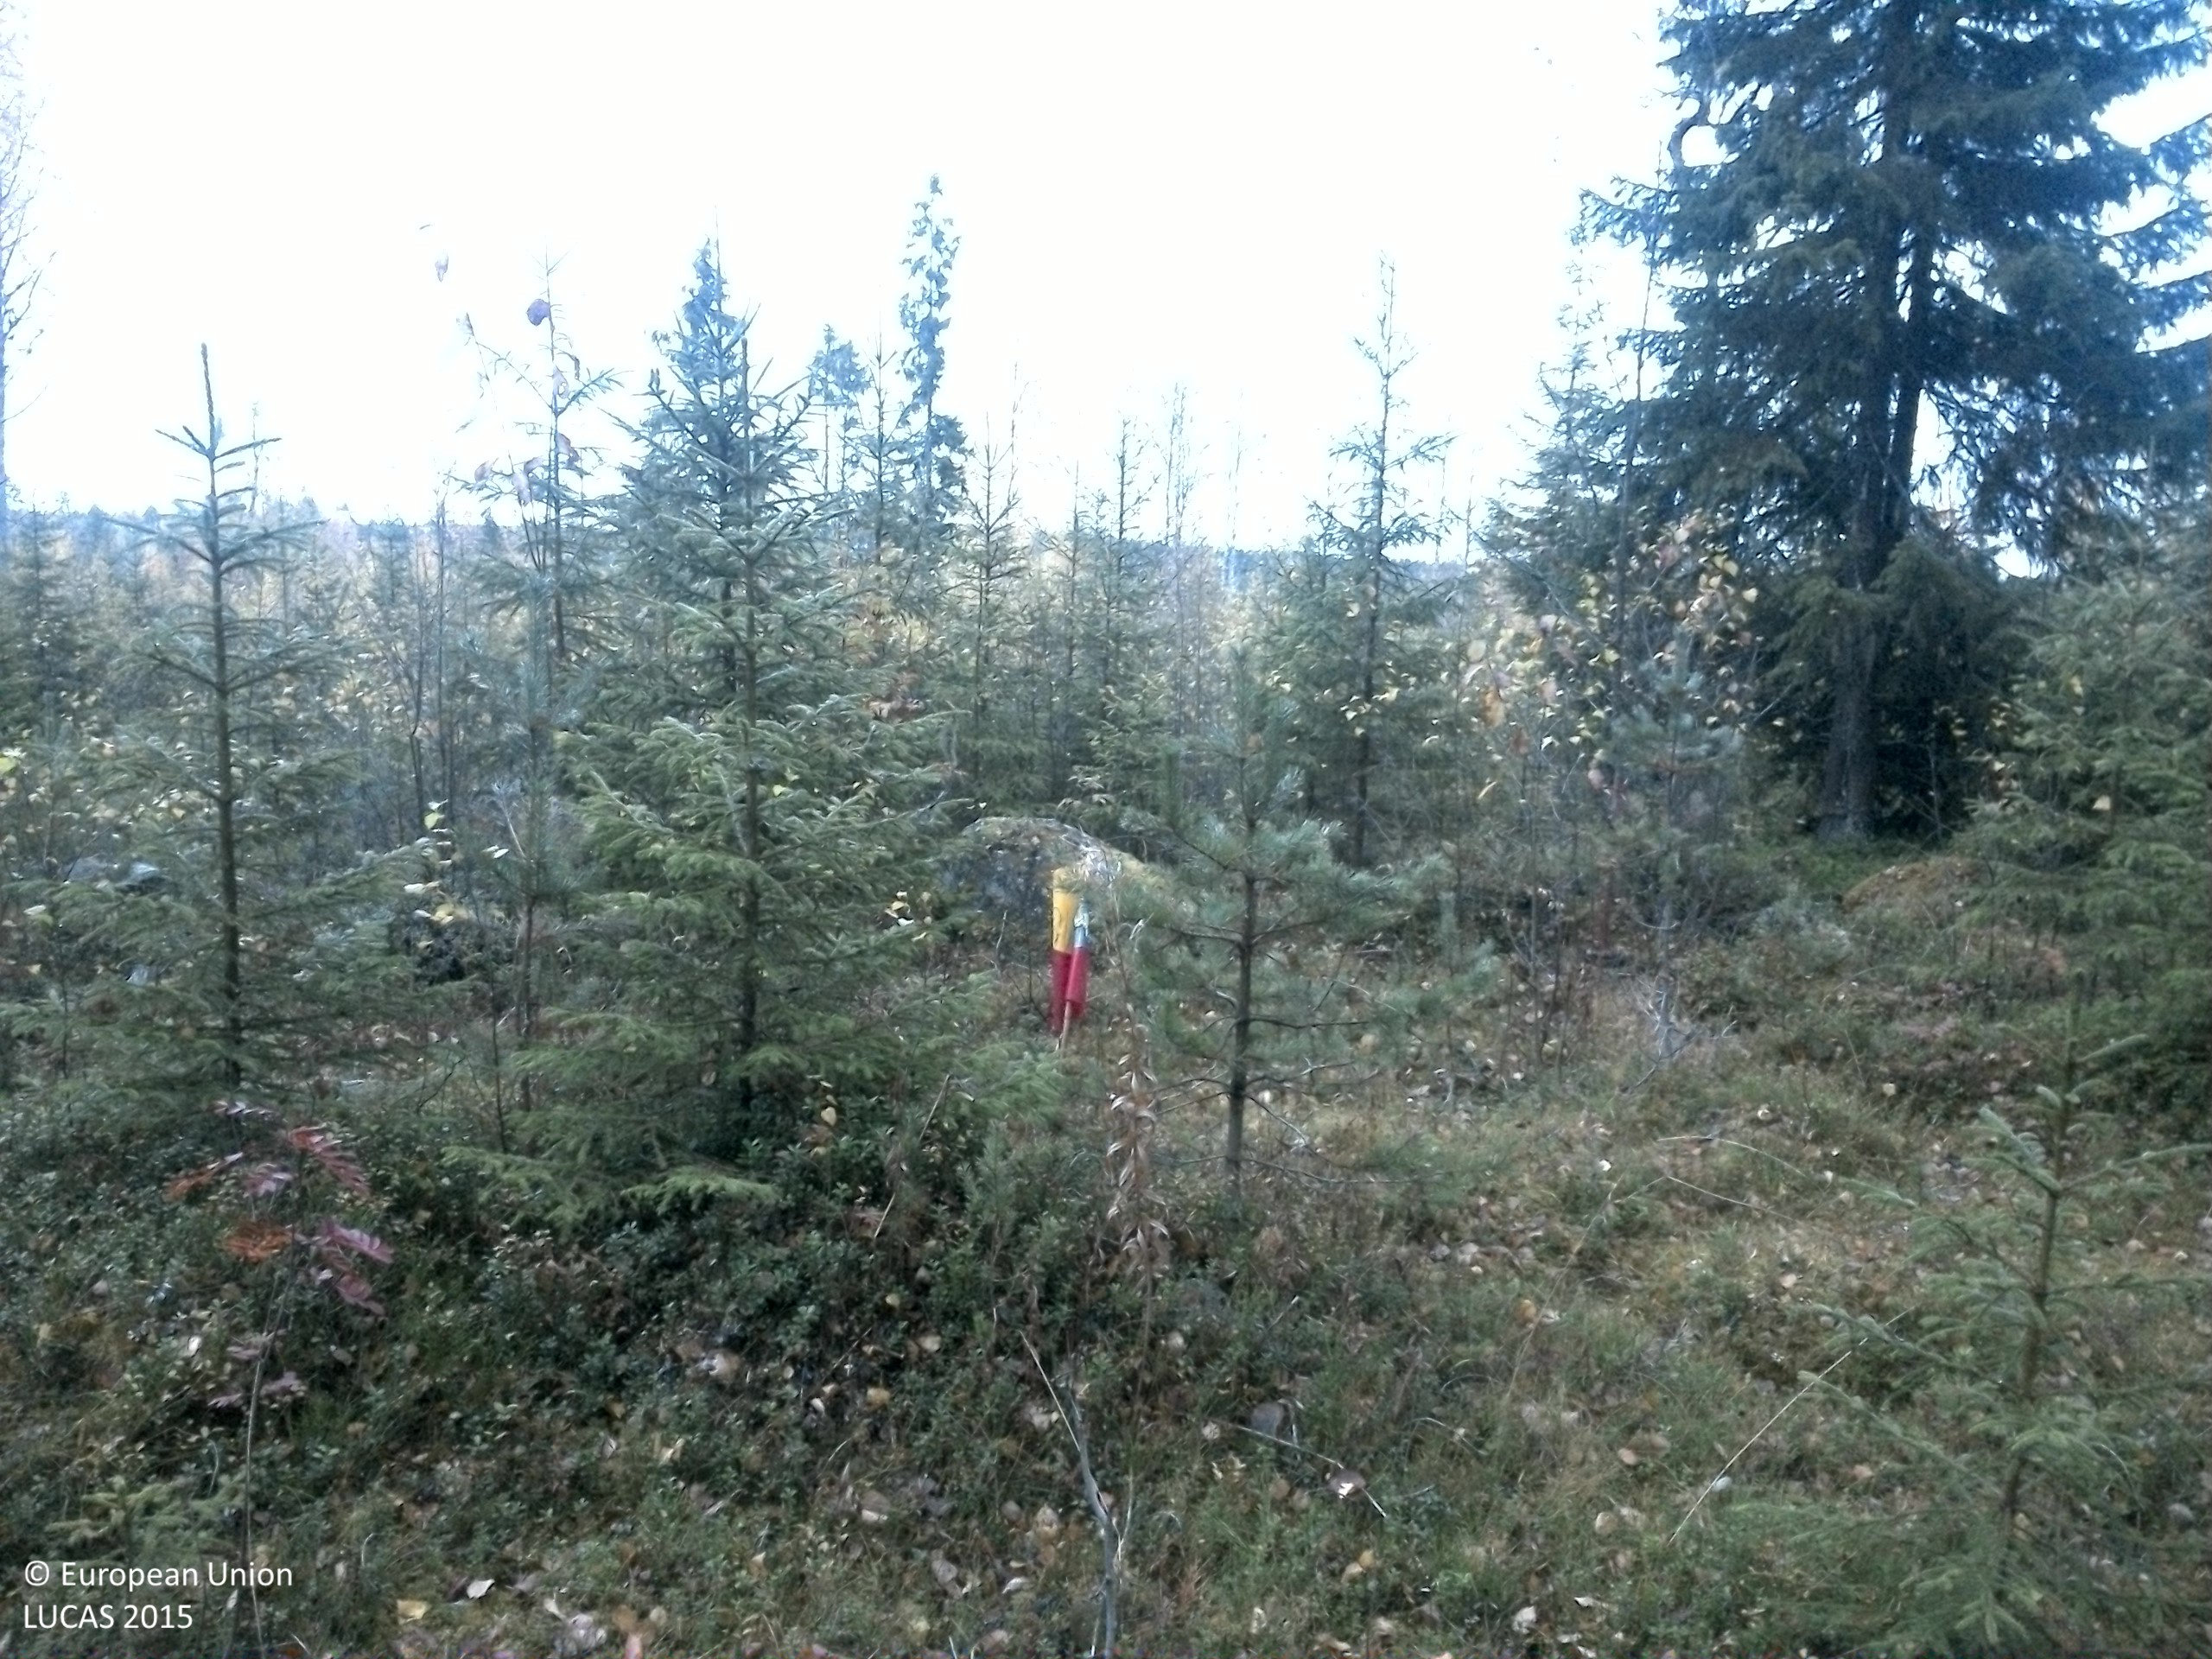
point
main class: Woodland
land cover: Spruce dominated mixed woodland
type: boreal forest
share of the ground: 50 - 75 %
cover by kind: coniferous forest trees 35 %, broadleaved forest trees 25 %, shrubs 20 %, lichens and mosses 15 %, herbaceous plants 5 %
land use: Forestry
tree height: < 5 m
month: October
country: SE
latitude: 64.0862
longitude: 15.9803
